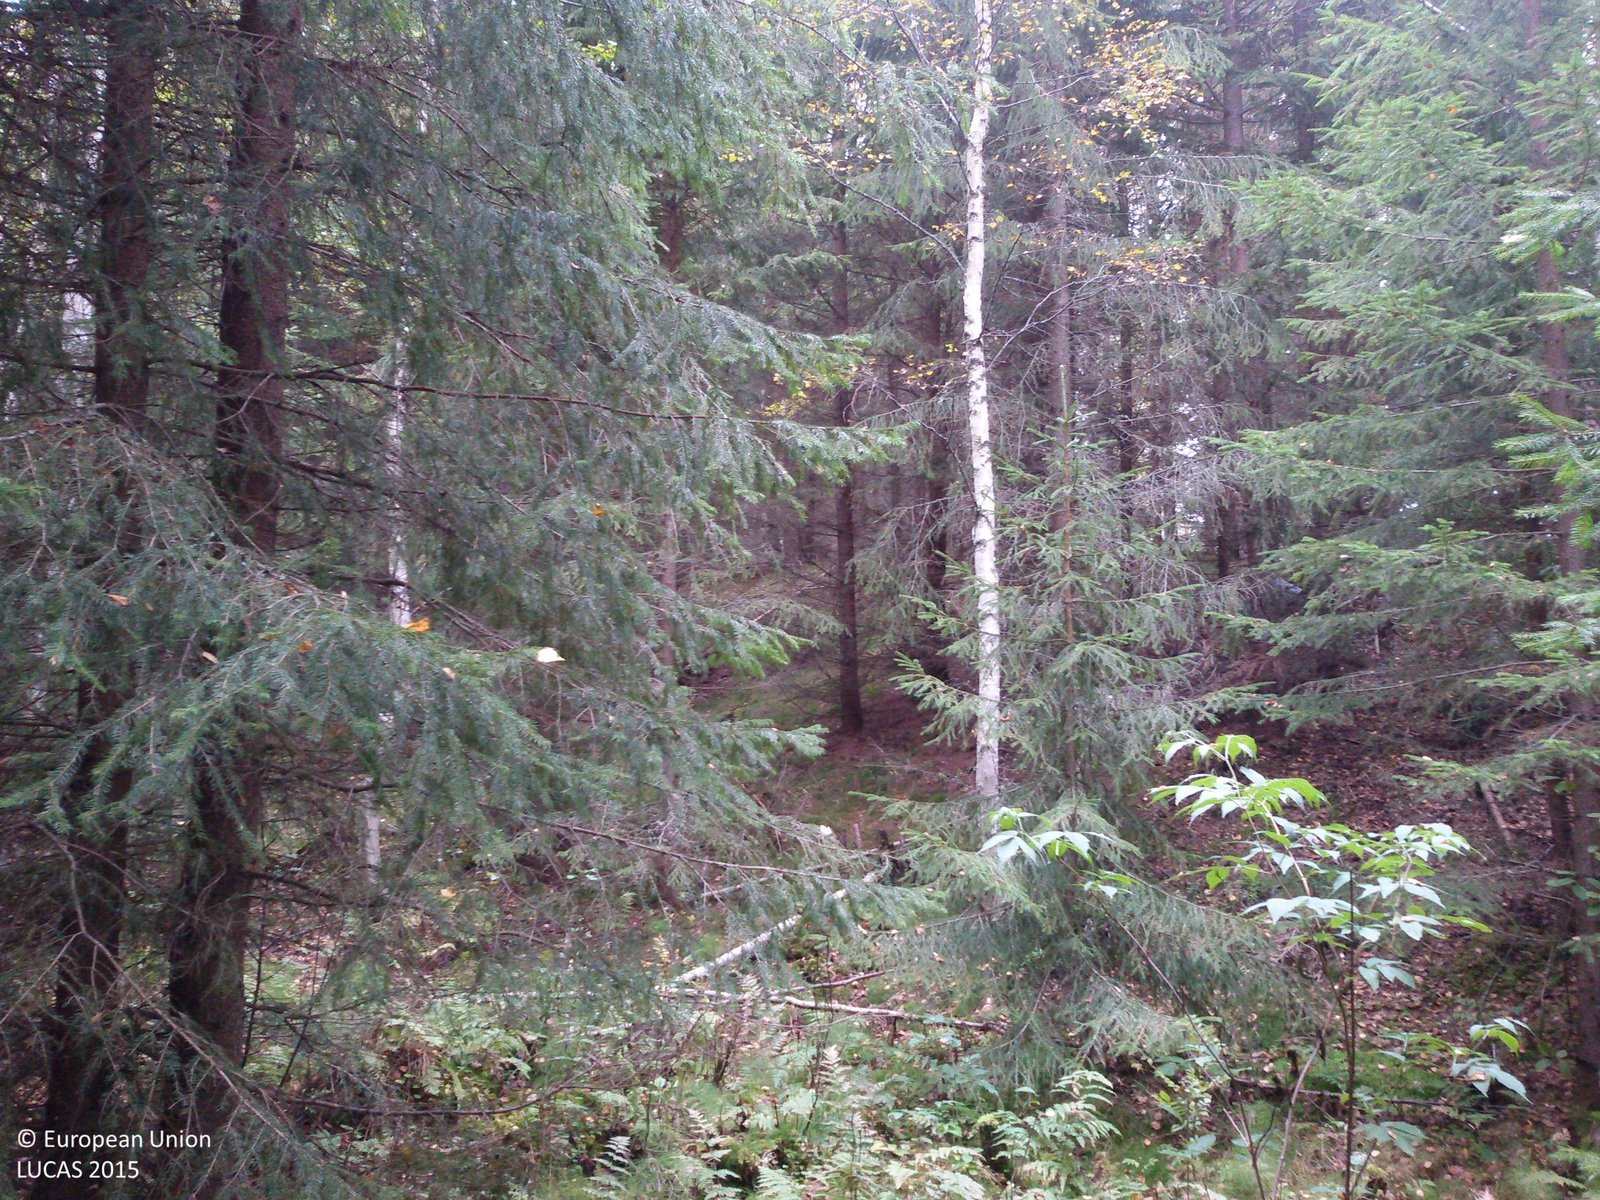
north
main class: Woodland
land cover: Spruce dominated mixed woodland
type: boreal forest
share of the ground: > 75 %
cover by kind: coniferous forest trees 50 %, broadleaved forest trees 30 %, herbaceous plants 10 %, lichens and mosses 10 %
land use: Forestry
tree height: > 5 m
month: September
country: SE
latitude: 60.7072
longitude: 14.9526
